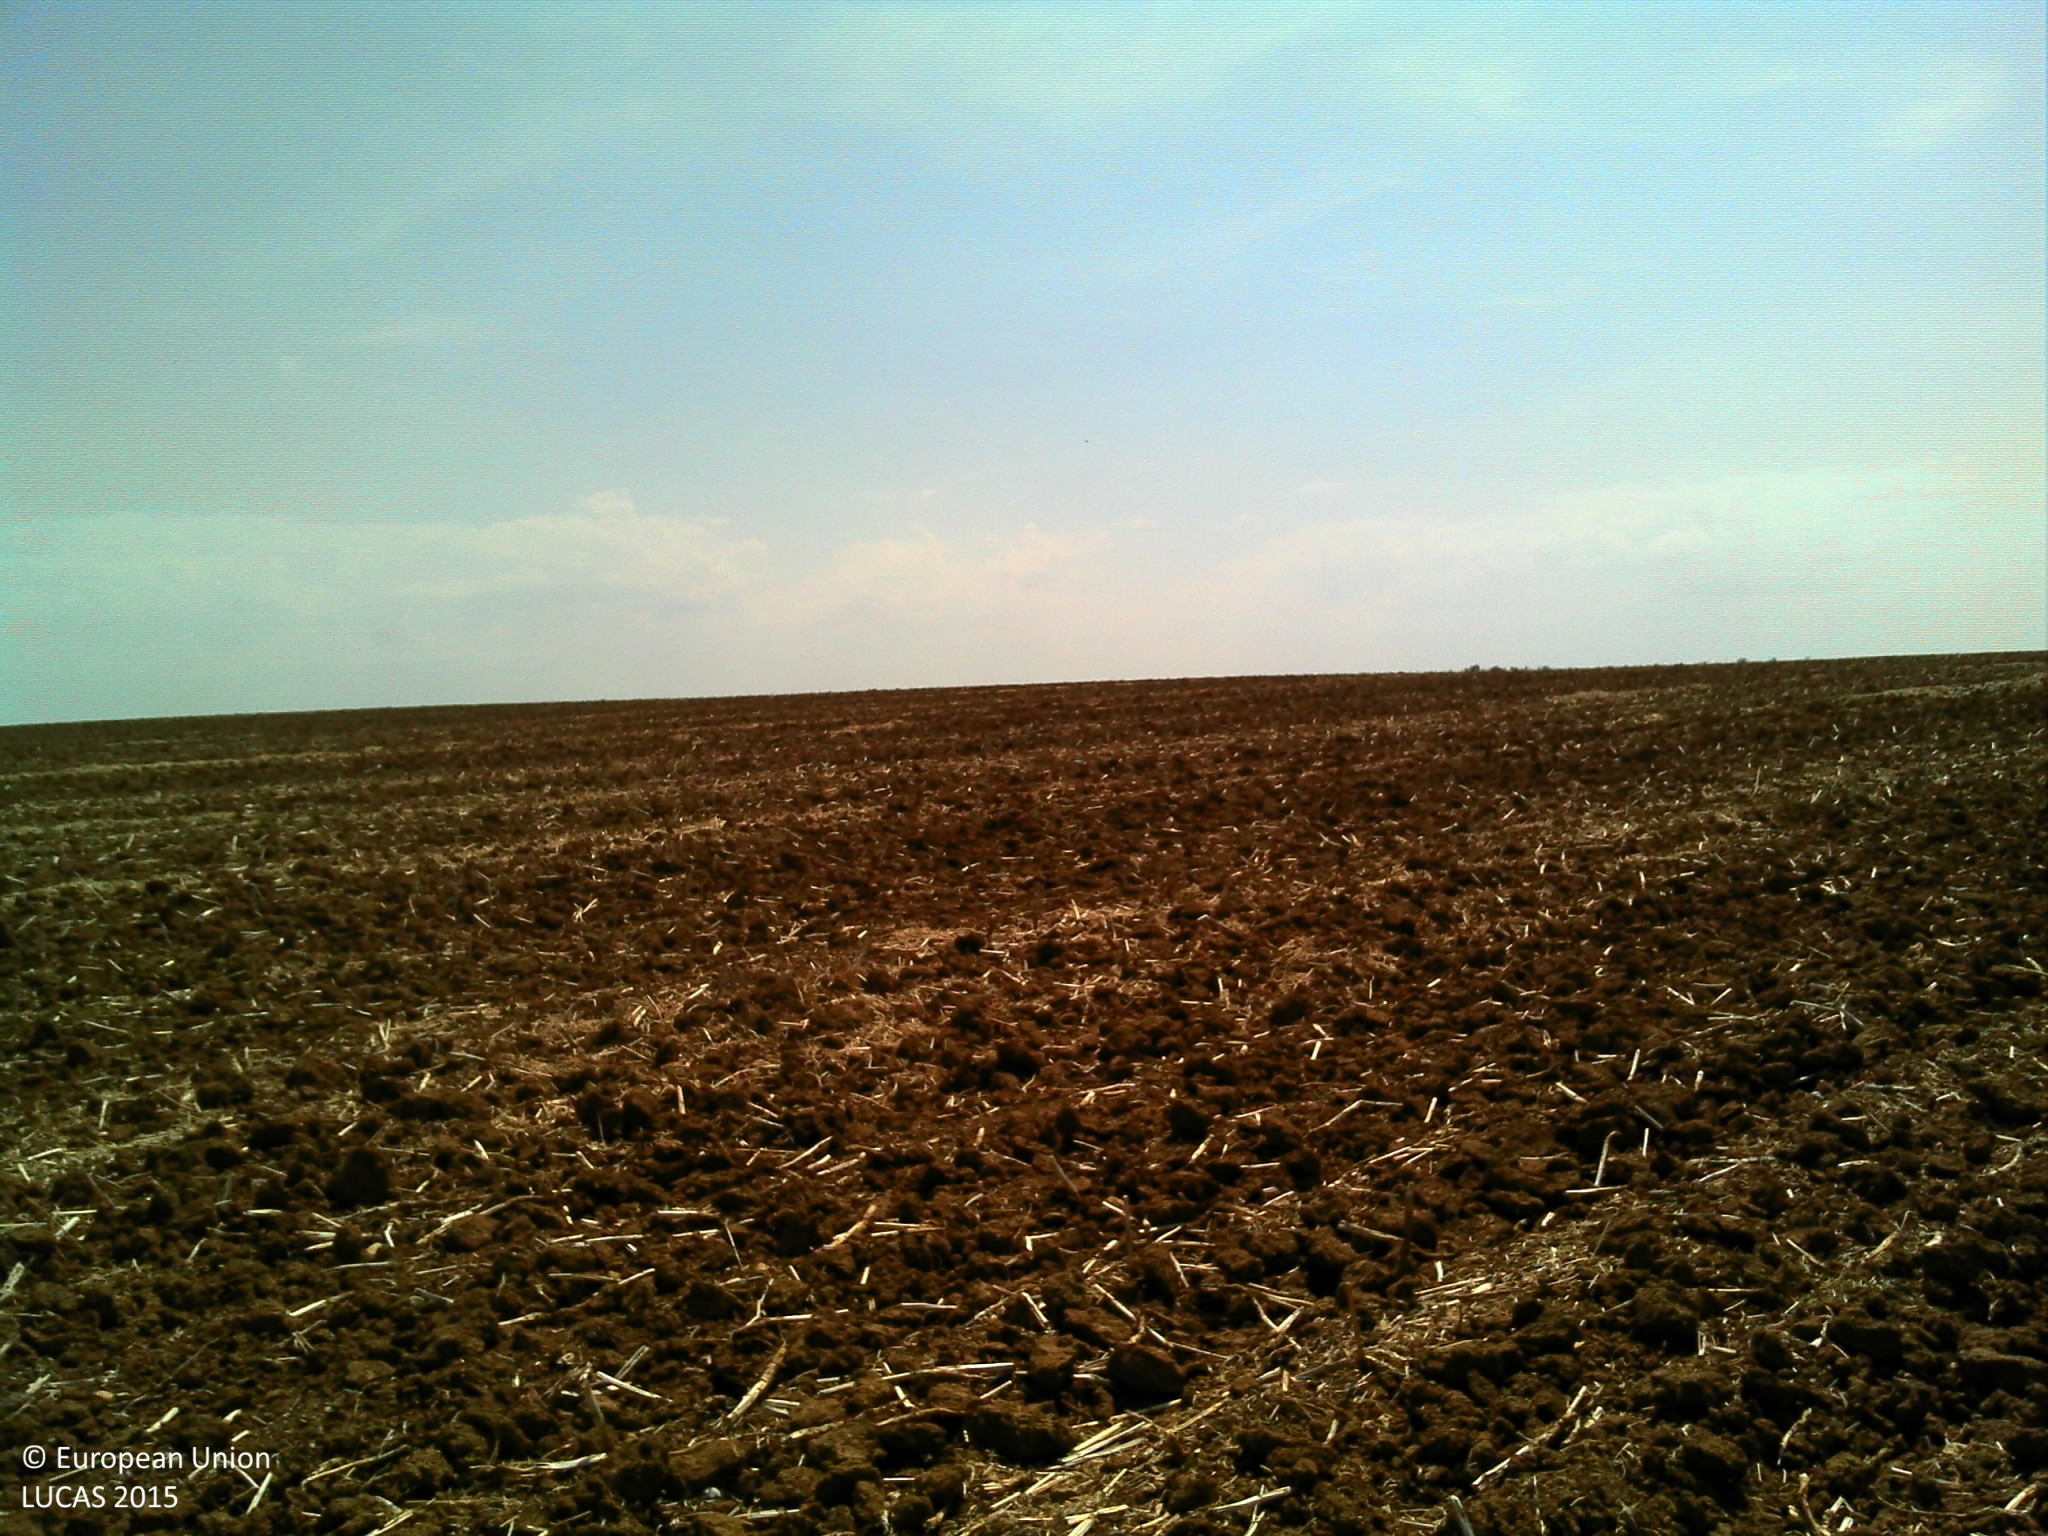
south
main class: Cropland
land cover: Rape and turnip rape
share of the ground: < 10 %
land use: Agriculture (excluding fallow land and kitchen gardens)
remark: Tilled/Sowed
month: August
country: FR
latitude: 48.3992
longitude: 5.0145
